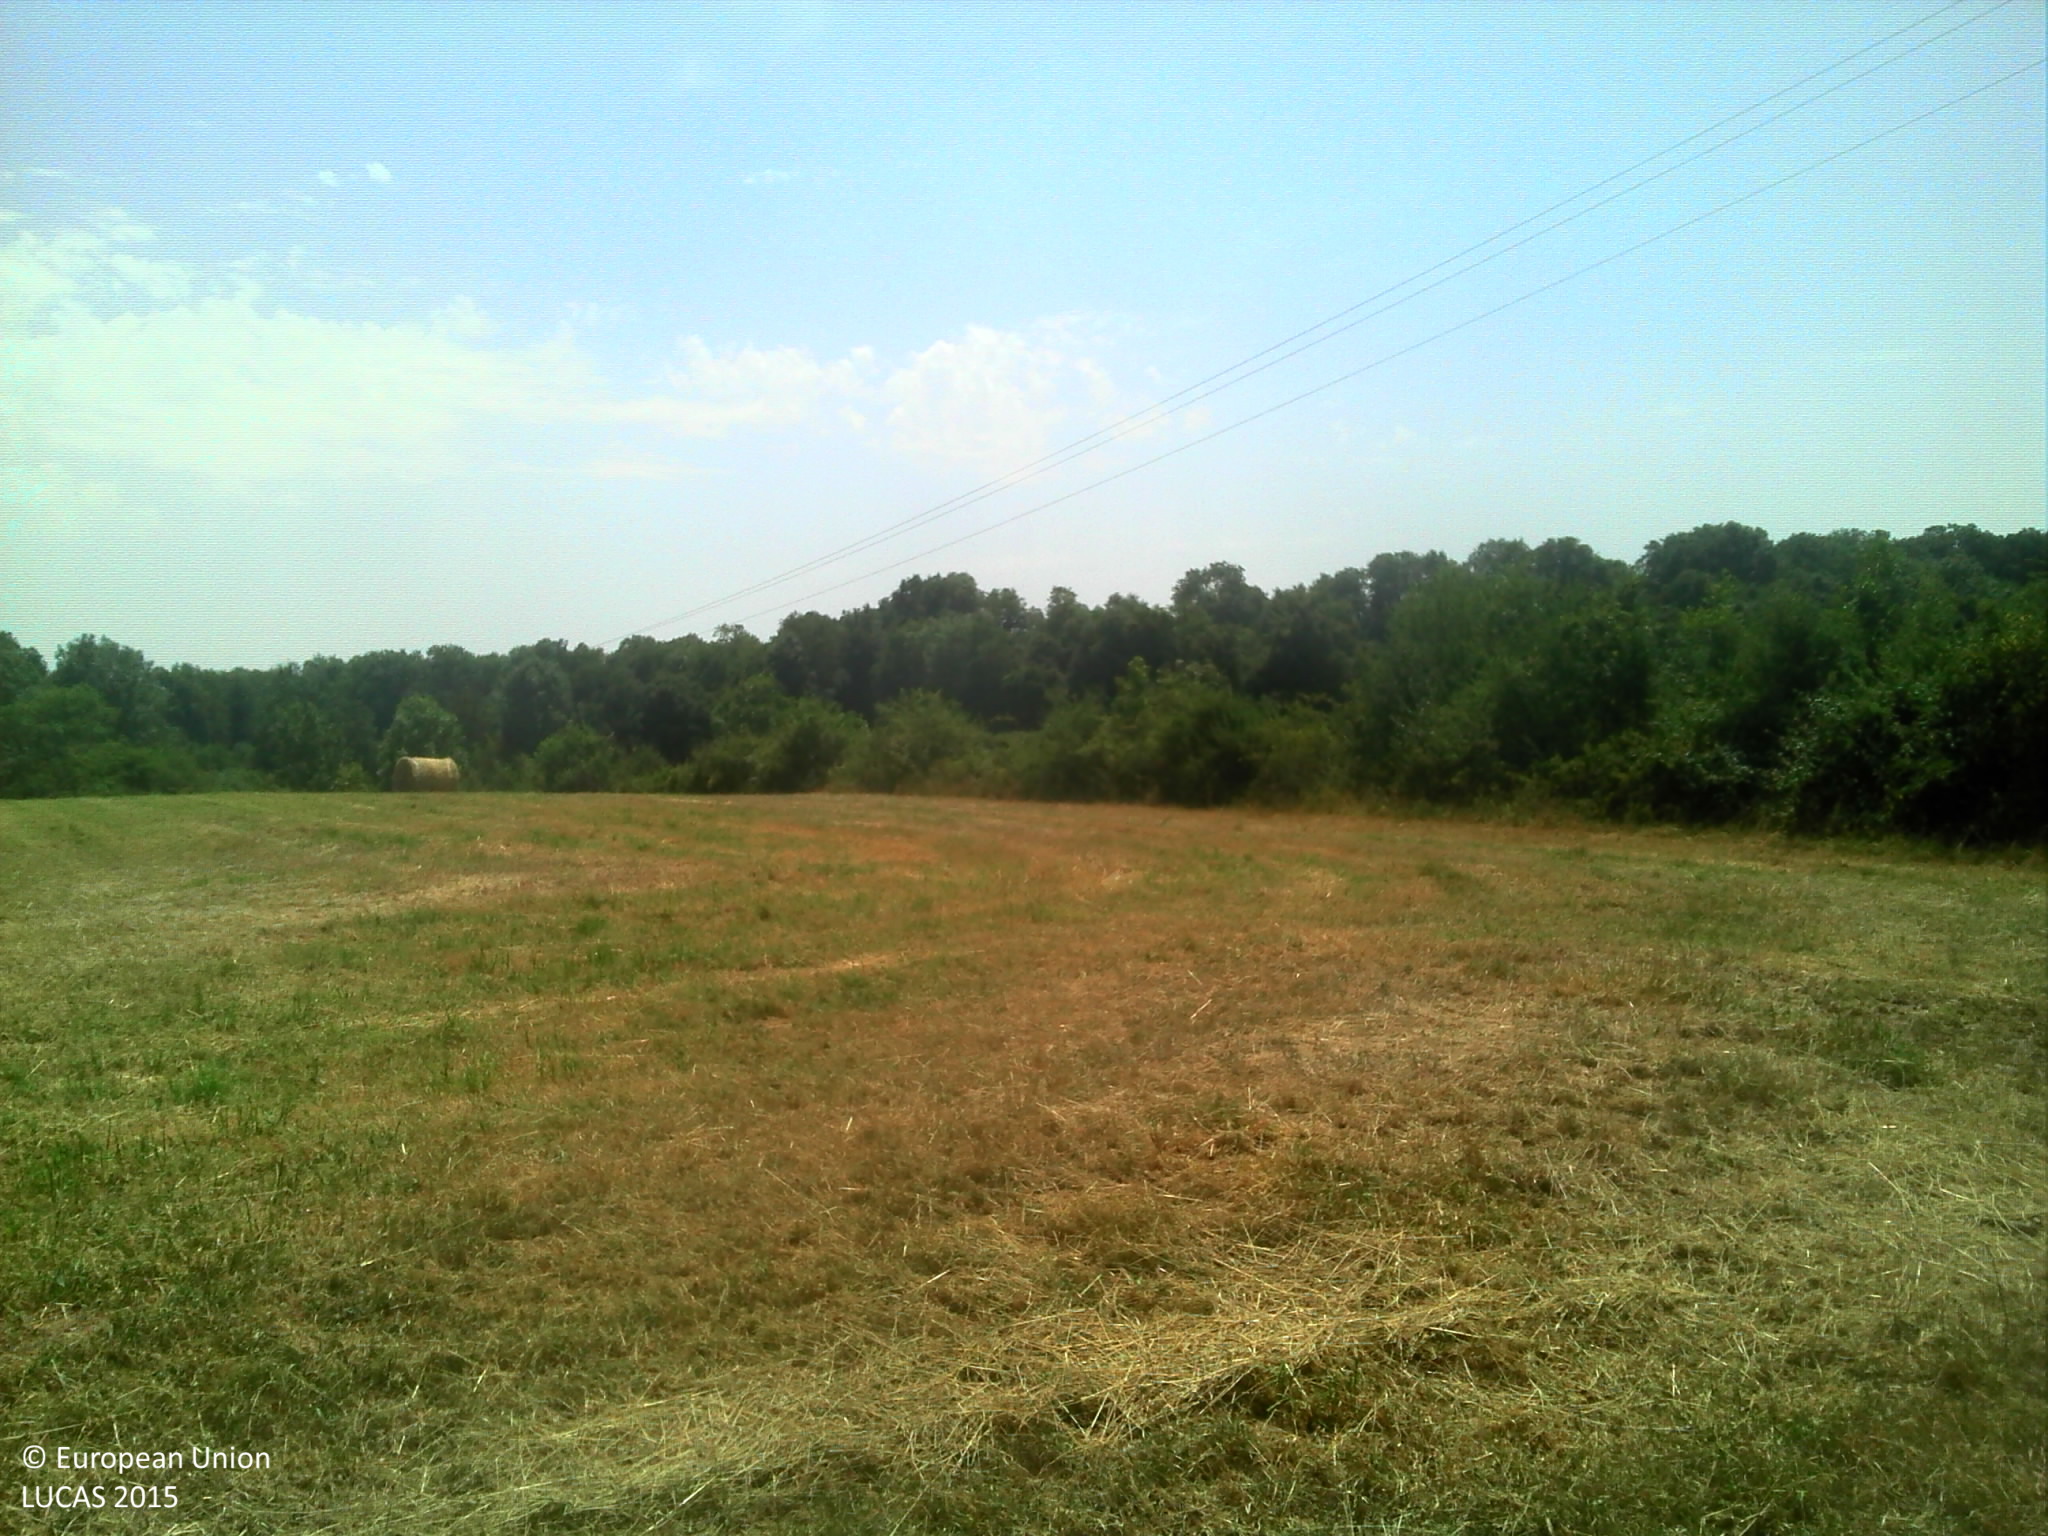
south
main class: Woodland
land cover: Broadleaved woodland
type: mesophytic deciduous forest
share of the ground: > 75 %
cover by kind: broadleaved forest trees 60 %, shrubs 20 %, herbaceous plants 20 %
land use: Forestry
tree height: > 5 m
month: July
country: FR
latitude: 45.7983
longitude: 5.3336
